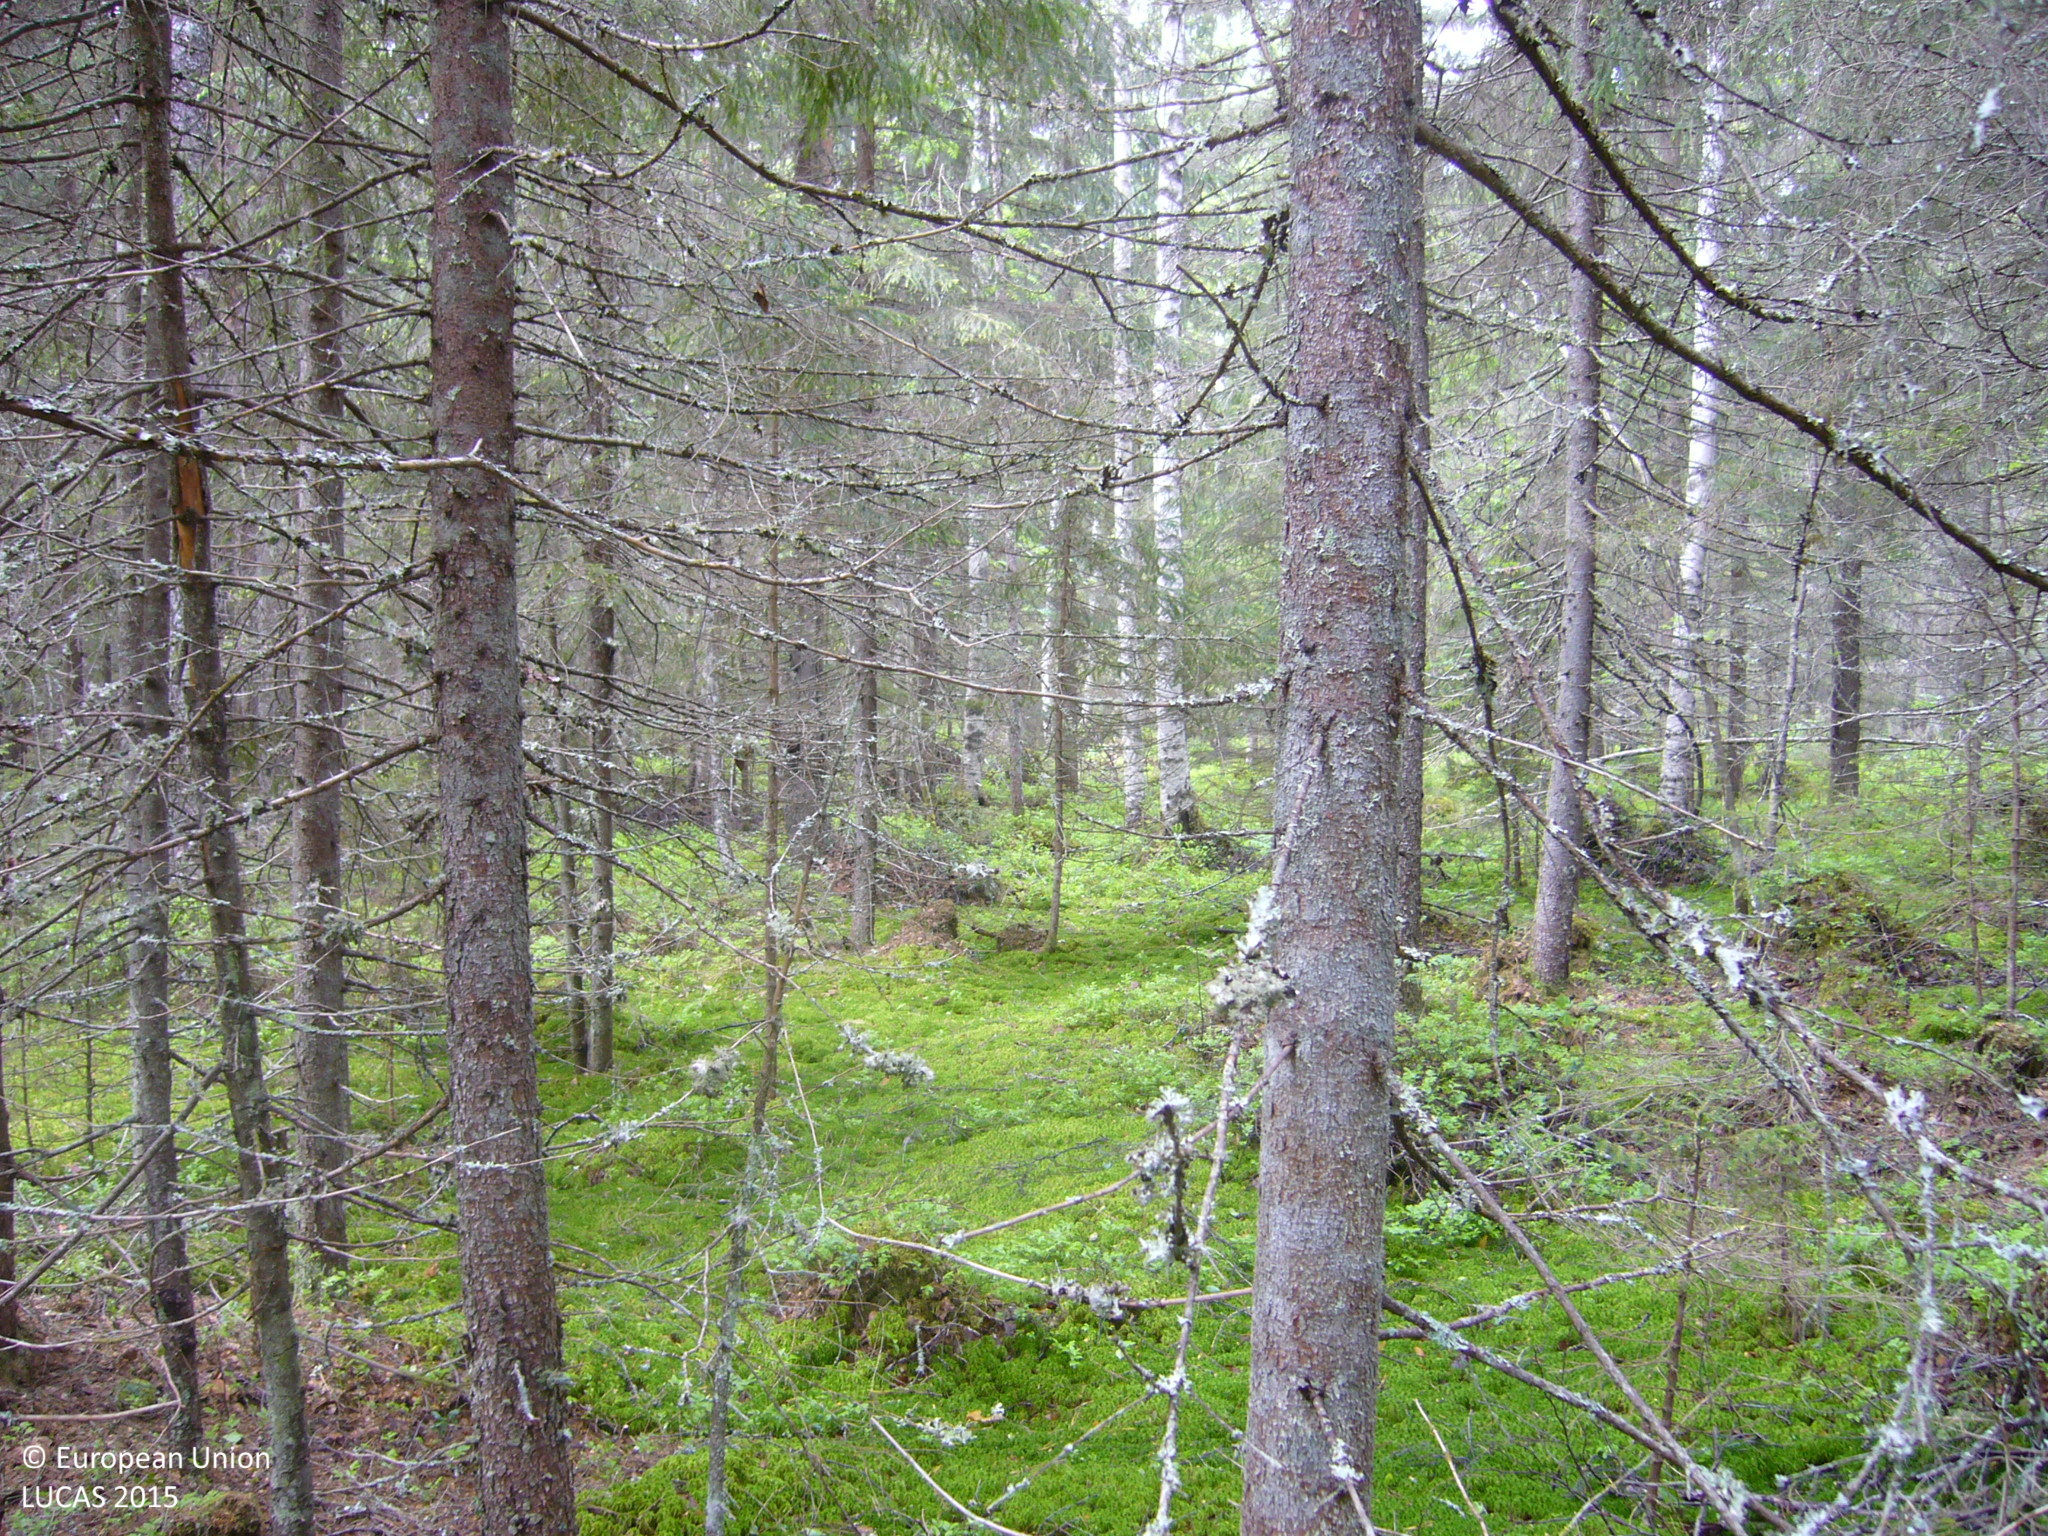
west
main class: Woodland
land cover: Spruce dominated mixed woodland
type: boreal forest
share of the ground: > 75 %
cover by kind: coniferous forest trees 60 %, broadleaved forest trees 30 %, shrubs 10 %
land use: Forestry
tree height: > 5 m
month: June
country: FI
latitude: 63.2396
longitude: 26.2269
